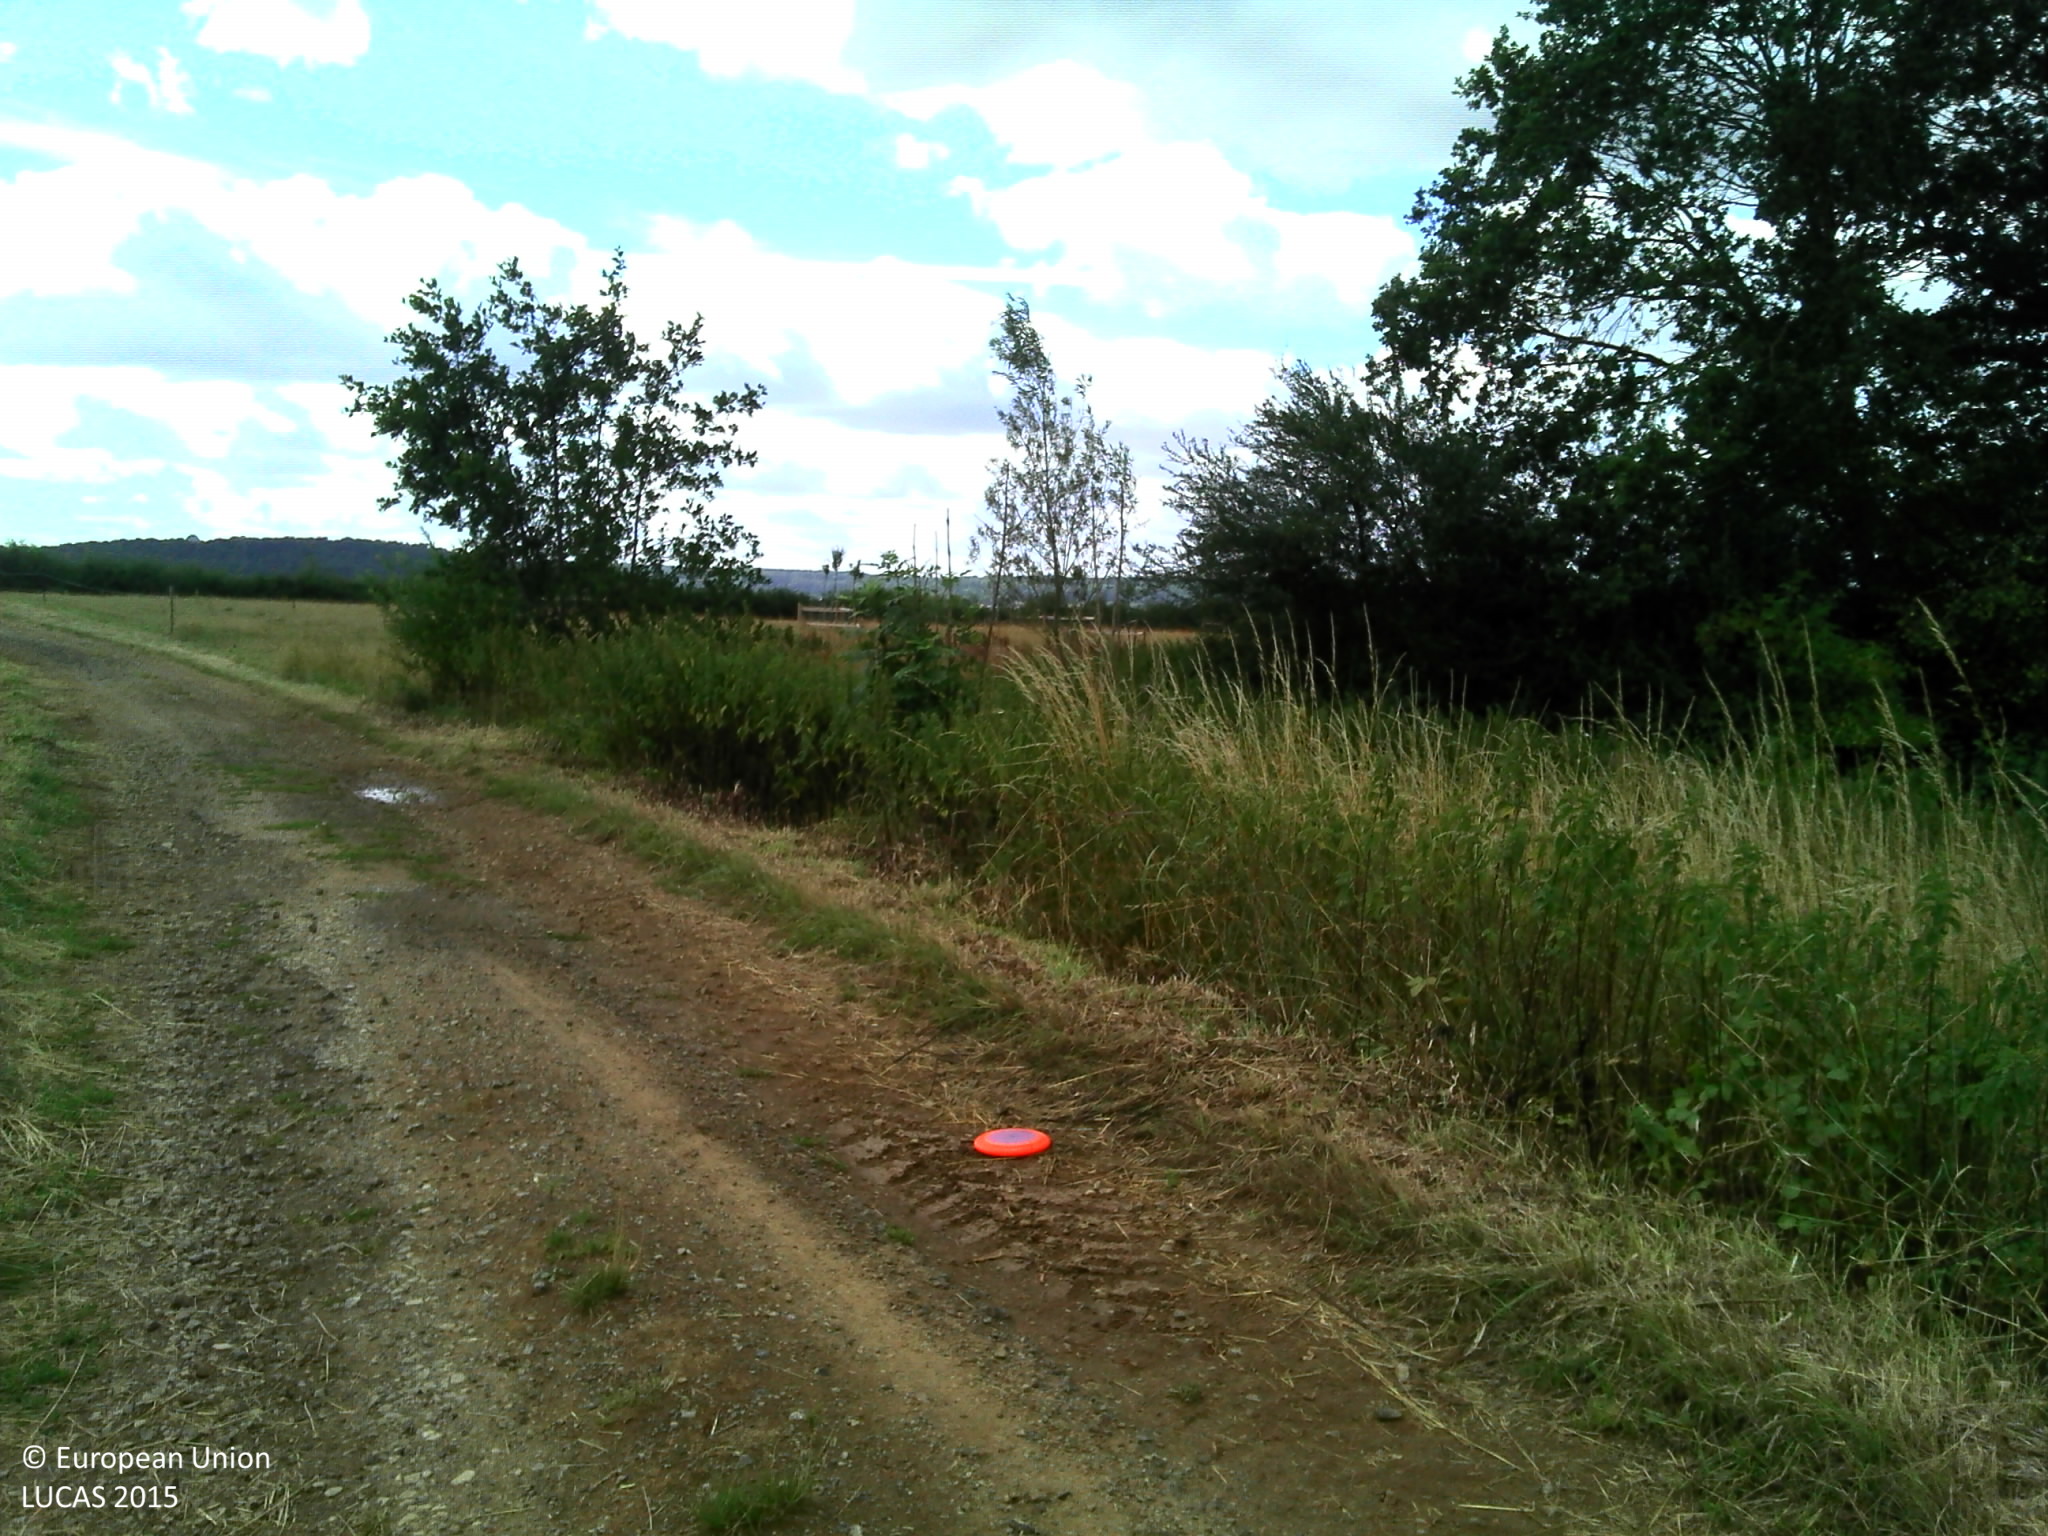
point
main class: Cropland
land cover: Temporary grasslands
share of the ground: > 75 %
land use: Agriculture (excluding fallow land and kitchen gardens)
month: July
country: BE
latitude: 49.5860
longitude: 5.8355
